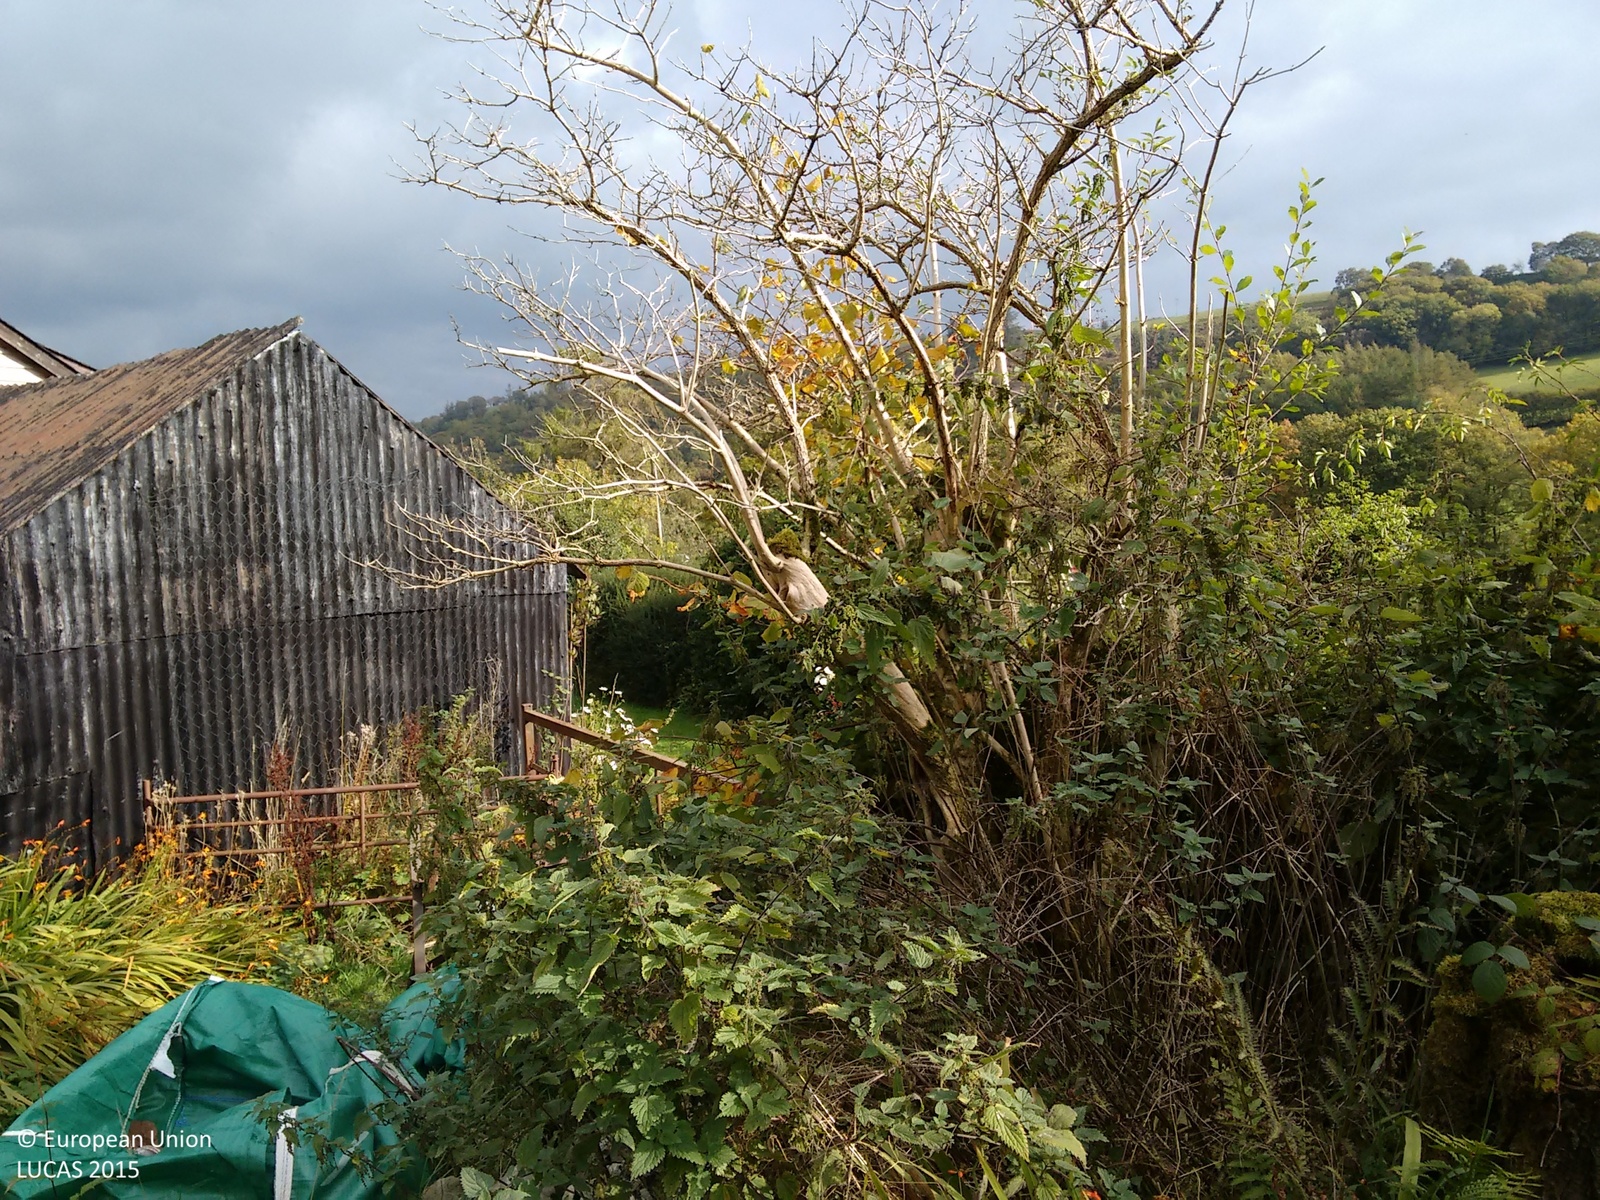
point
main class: Woodland
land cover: Broadleaved woodland
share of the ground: > 75 %
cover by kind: broadleaved forest trees 60 %, herbaceous plants 40 %
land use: Residential
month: October
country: GB
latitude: 52.4147
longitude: -3.5677
